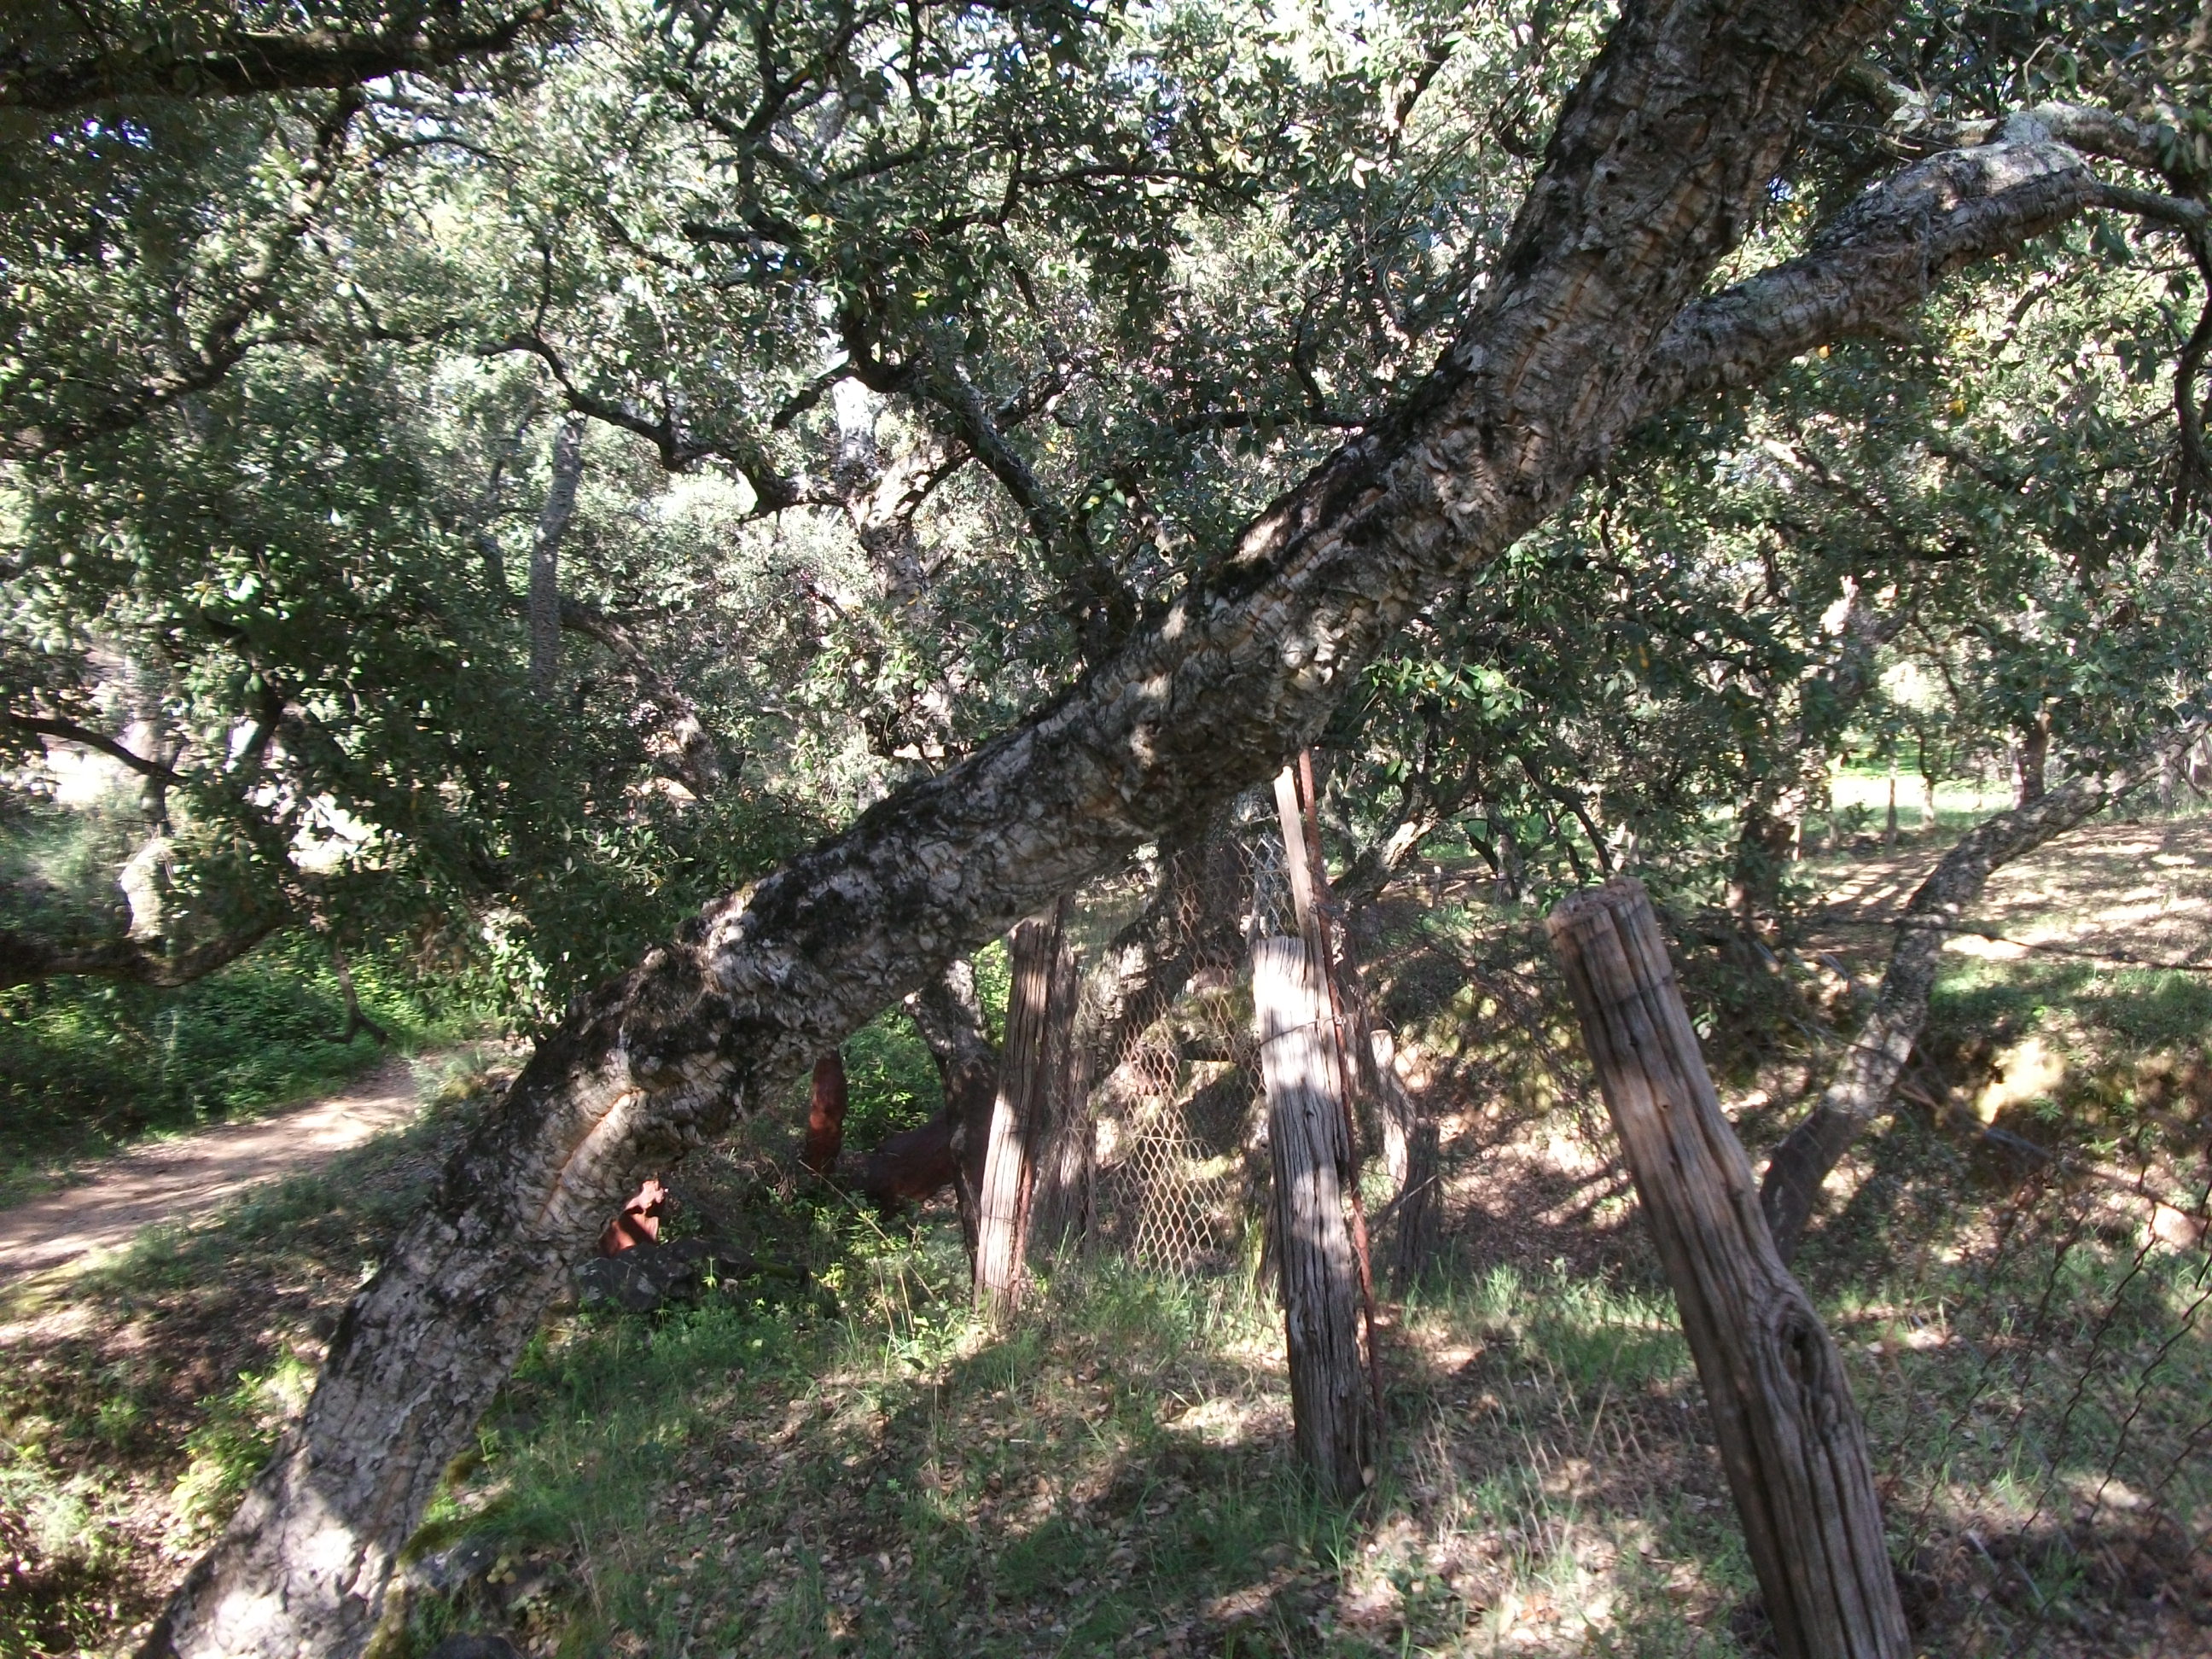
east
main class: Woodland
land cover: Broadleaved woodland
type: broadleaved evergreen forest
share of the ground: 50 - 75 %
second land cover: Grassland without tree/shrub cover
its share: > 75 %
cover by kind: broadleaved forest trees 60 %, herbaceous plants 40 %
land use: Forestry
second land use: Agriculture (excluding fallow land and kitchen gardens)
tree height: > 5 m
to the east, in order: Broadleaved woodland; Grassland without tree/shrub cover; Dry stone walls; Fences; Broadleaved woodland; Dry stone walls; Fences; Grass margins; Paved roads, cycling and walking lanes; Grass margins; Fences; Broadleaved woodland
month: April
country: ES
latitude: 37.8698
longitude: -6.6763
